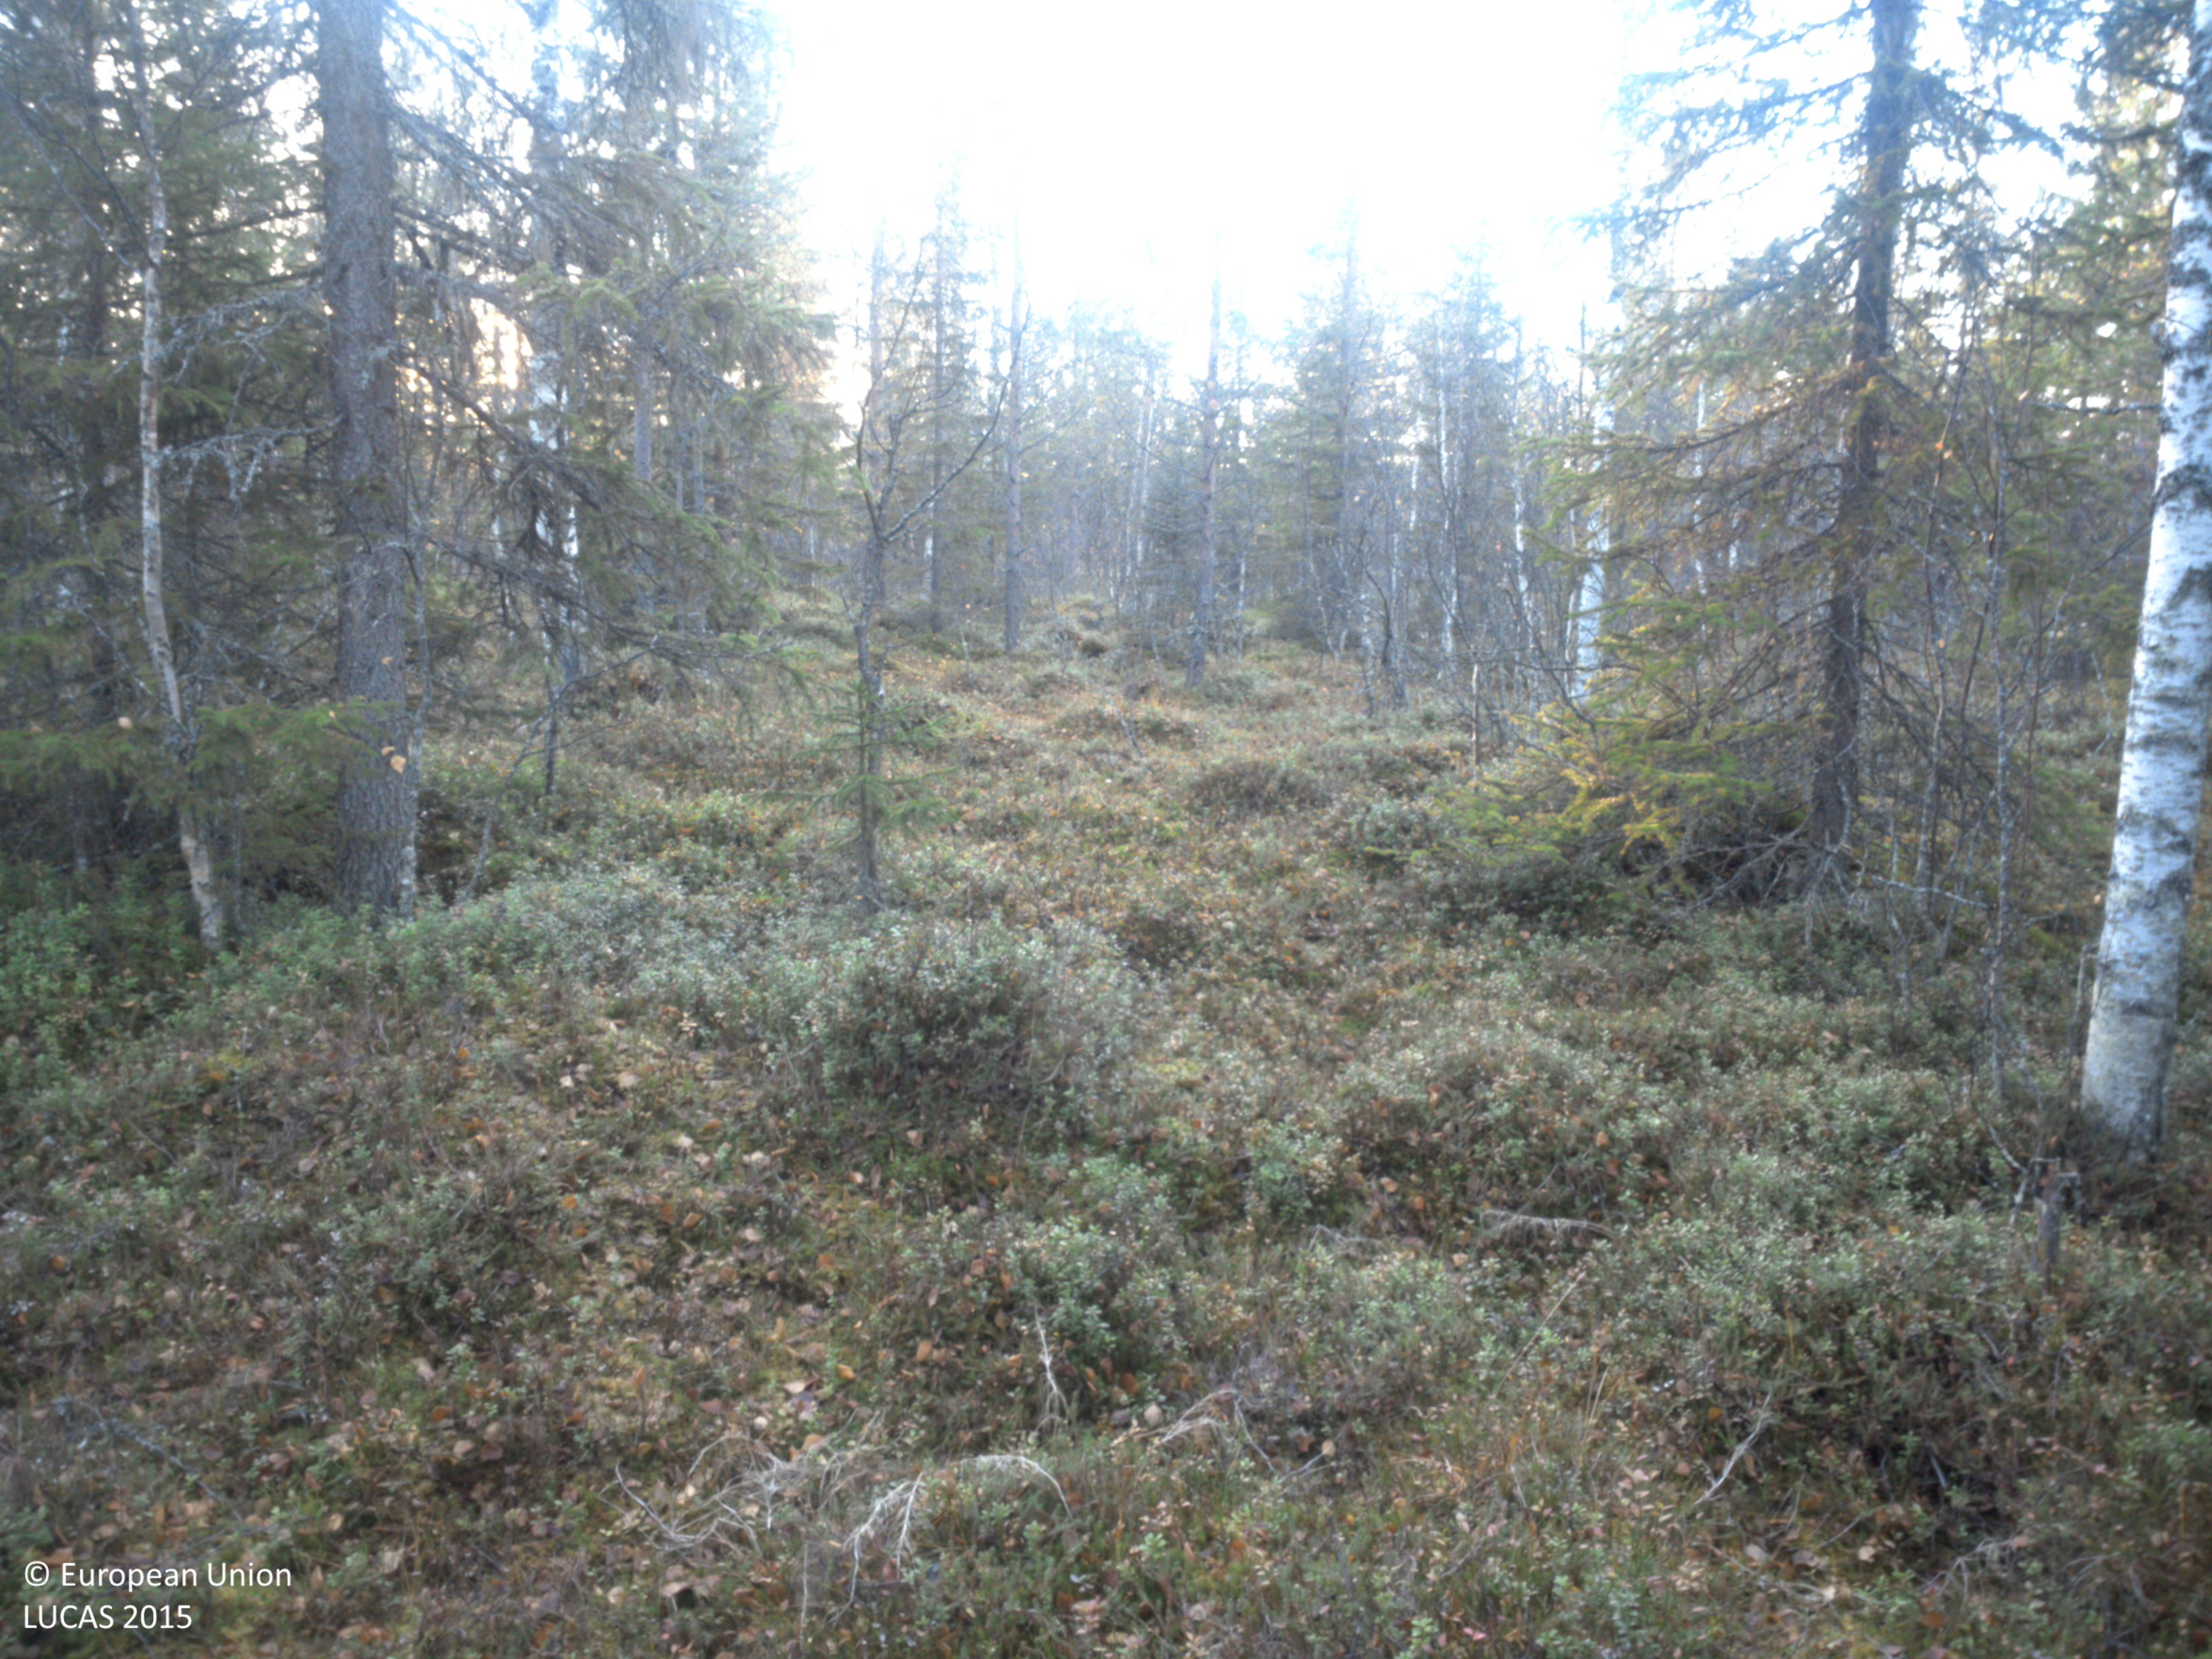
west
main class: Woodland
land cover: Spruce dominated mixed woodland
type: boreal forest
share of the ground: 50 - 75 %
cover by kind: coniferous forest trees 45 %, shrubs 40 %, broadleaved forest trees 15 %
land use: Forestry
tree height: > 5 m
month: October
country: SE
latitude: 64.8399
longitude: 18.2077
